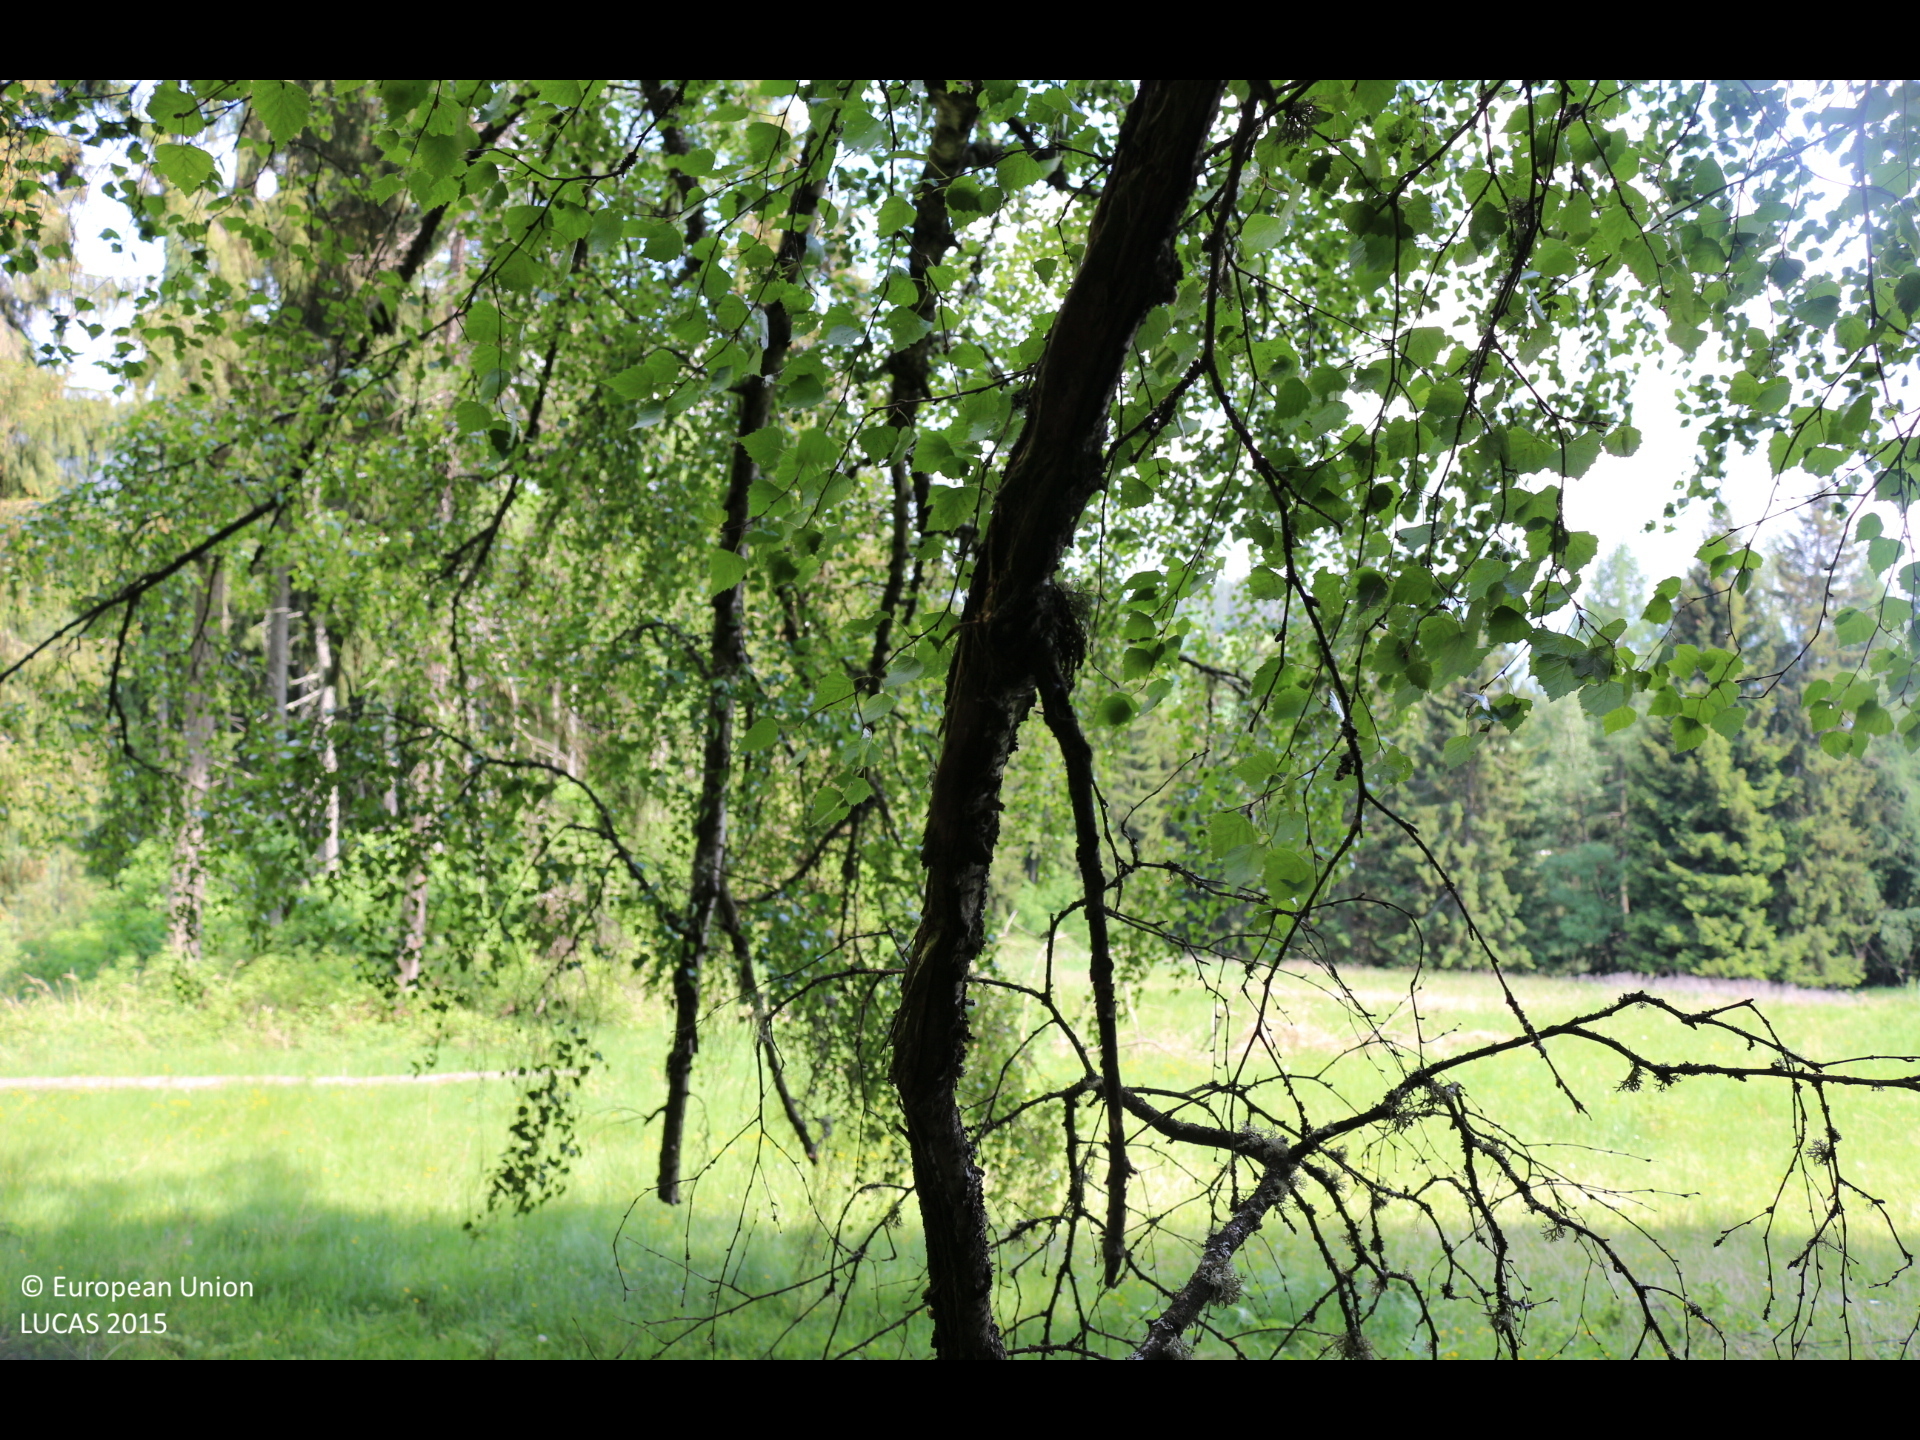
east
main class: Woodland
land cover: Spruce dominated coniferous woodland
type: alpine coniferous forest
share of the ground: > 75 %
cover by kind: coniferous forest trees 100 %
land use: Forestry
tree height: > 5 m
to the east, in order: Spruce dominated coniferous woodland; Fences; Grassland without tree/shrub cover; Shrubland with sparse tree cover; Spruce dominated coniferous woodland; Tracks; Rocks and stones; Broadleaved woodland; Grassland with sparse tree/shrub cover; Fences; Grassland without tree/shrub cover; Fences; Artificial constructions in urban areas; Grassland with sparse tree/shrub cover
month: May
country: AT
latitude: 46.7706
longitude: 14.2798
